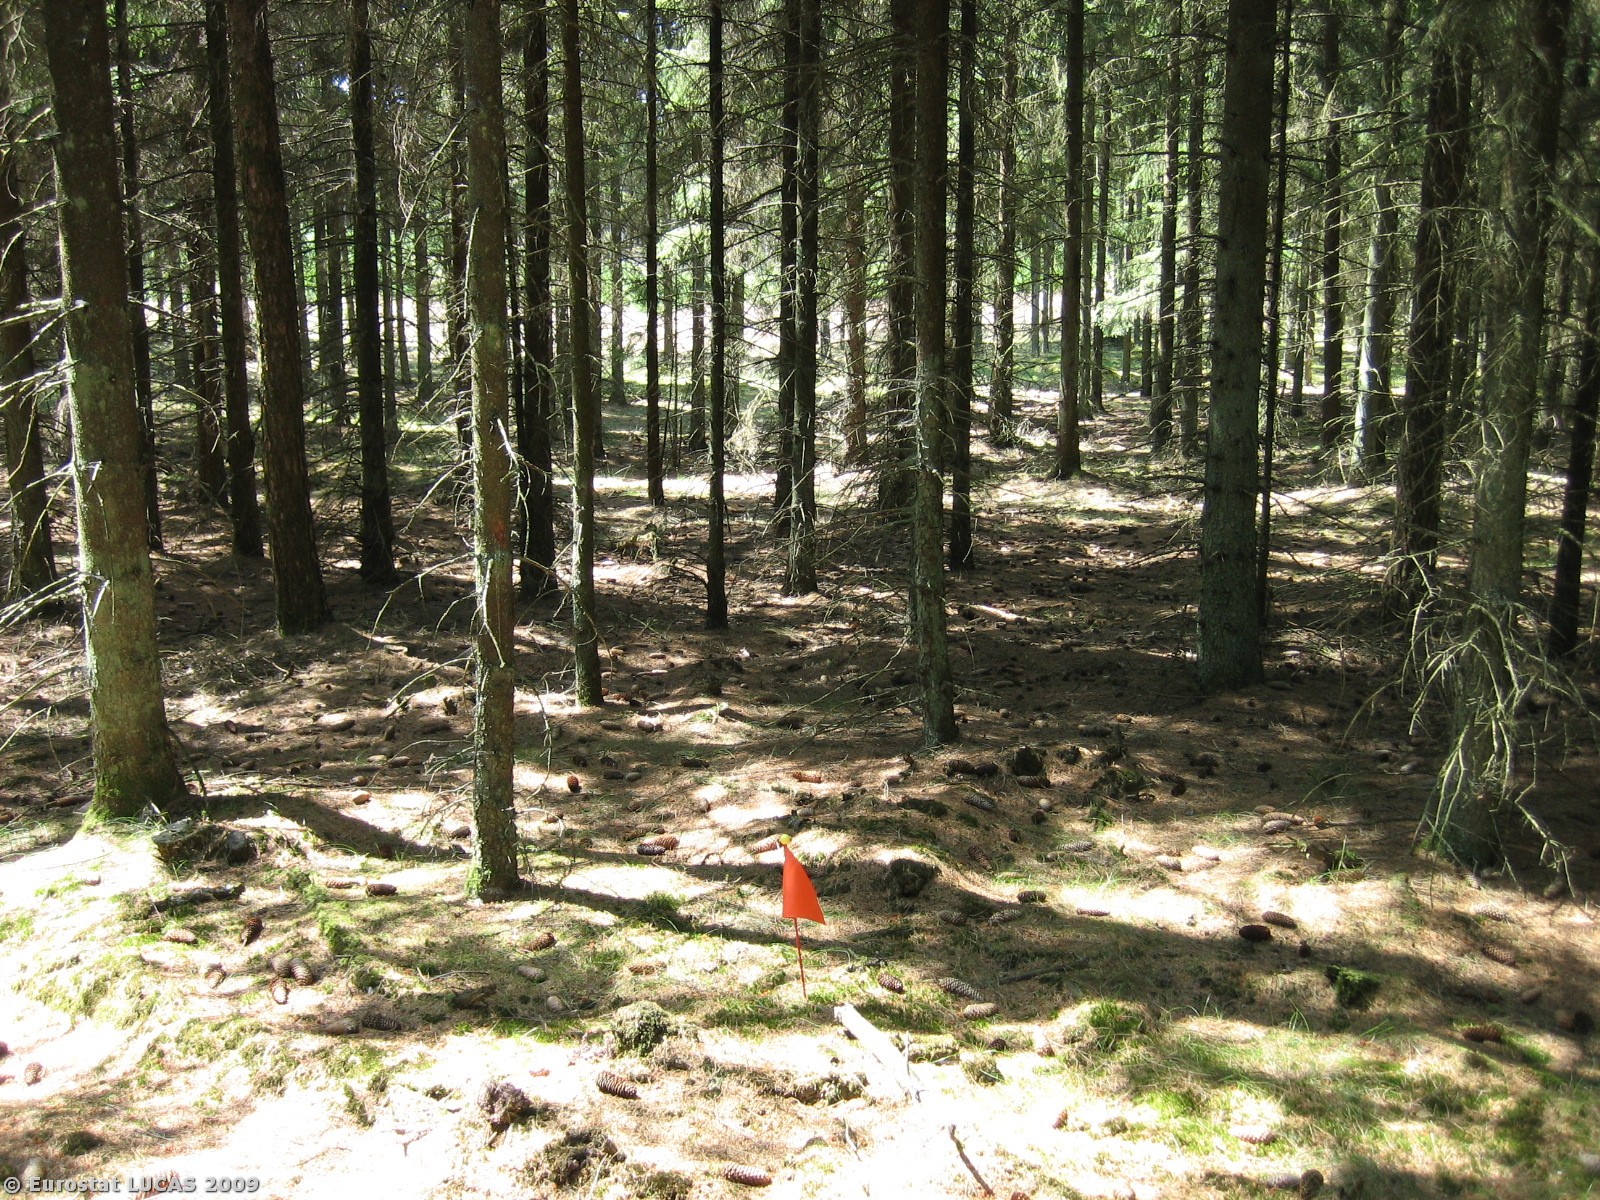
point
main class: Woodland
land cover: Coniferous woodland
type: hemiboreal forest and nemoral coniferous forest and mixed broadleaved-coniferous forest
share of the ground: > 75 %
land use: Forestry
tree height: > 5 m
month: July
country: DK
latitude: 55.6266
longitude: 9.0004
